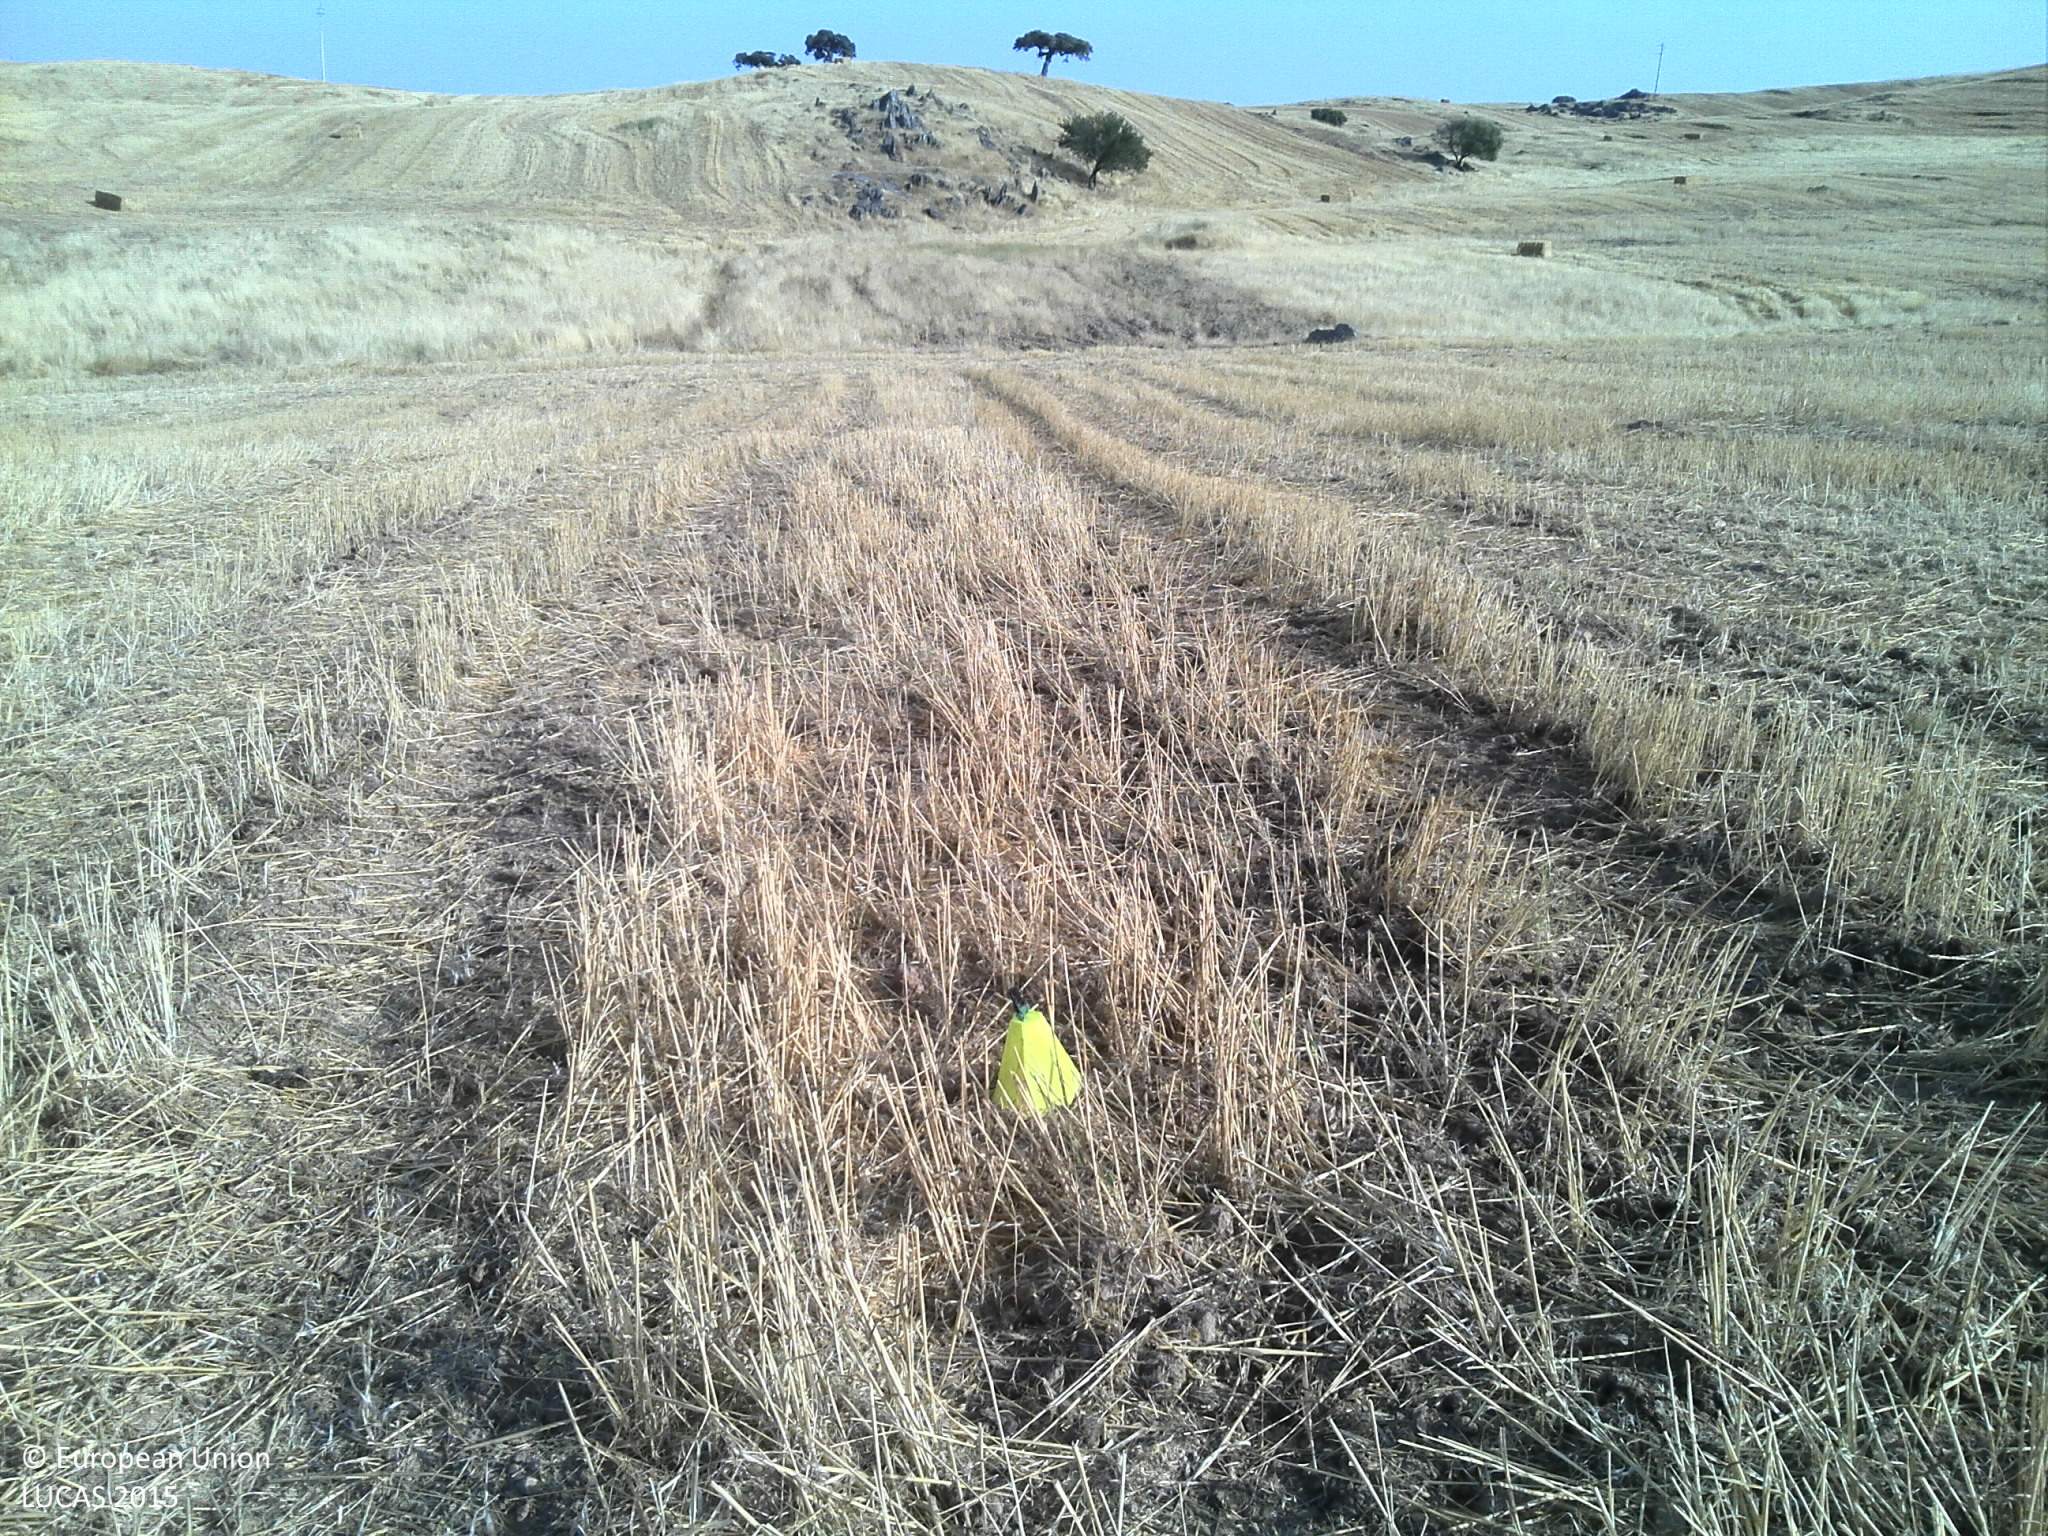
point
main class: Cropland
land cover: Triticale
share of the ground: < 10 %
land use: Agriculture (excluding fallow land and kitchen gardens)
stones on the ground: < 10 %
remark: Harvested field
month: July
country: PT
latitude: 38.7282
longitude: -7.3409
